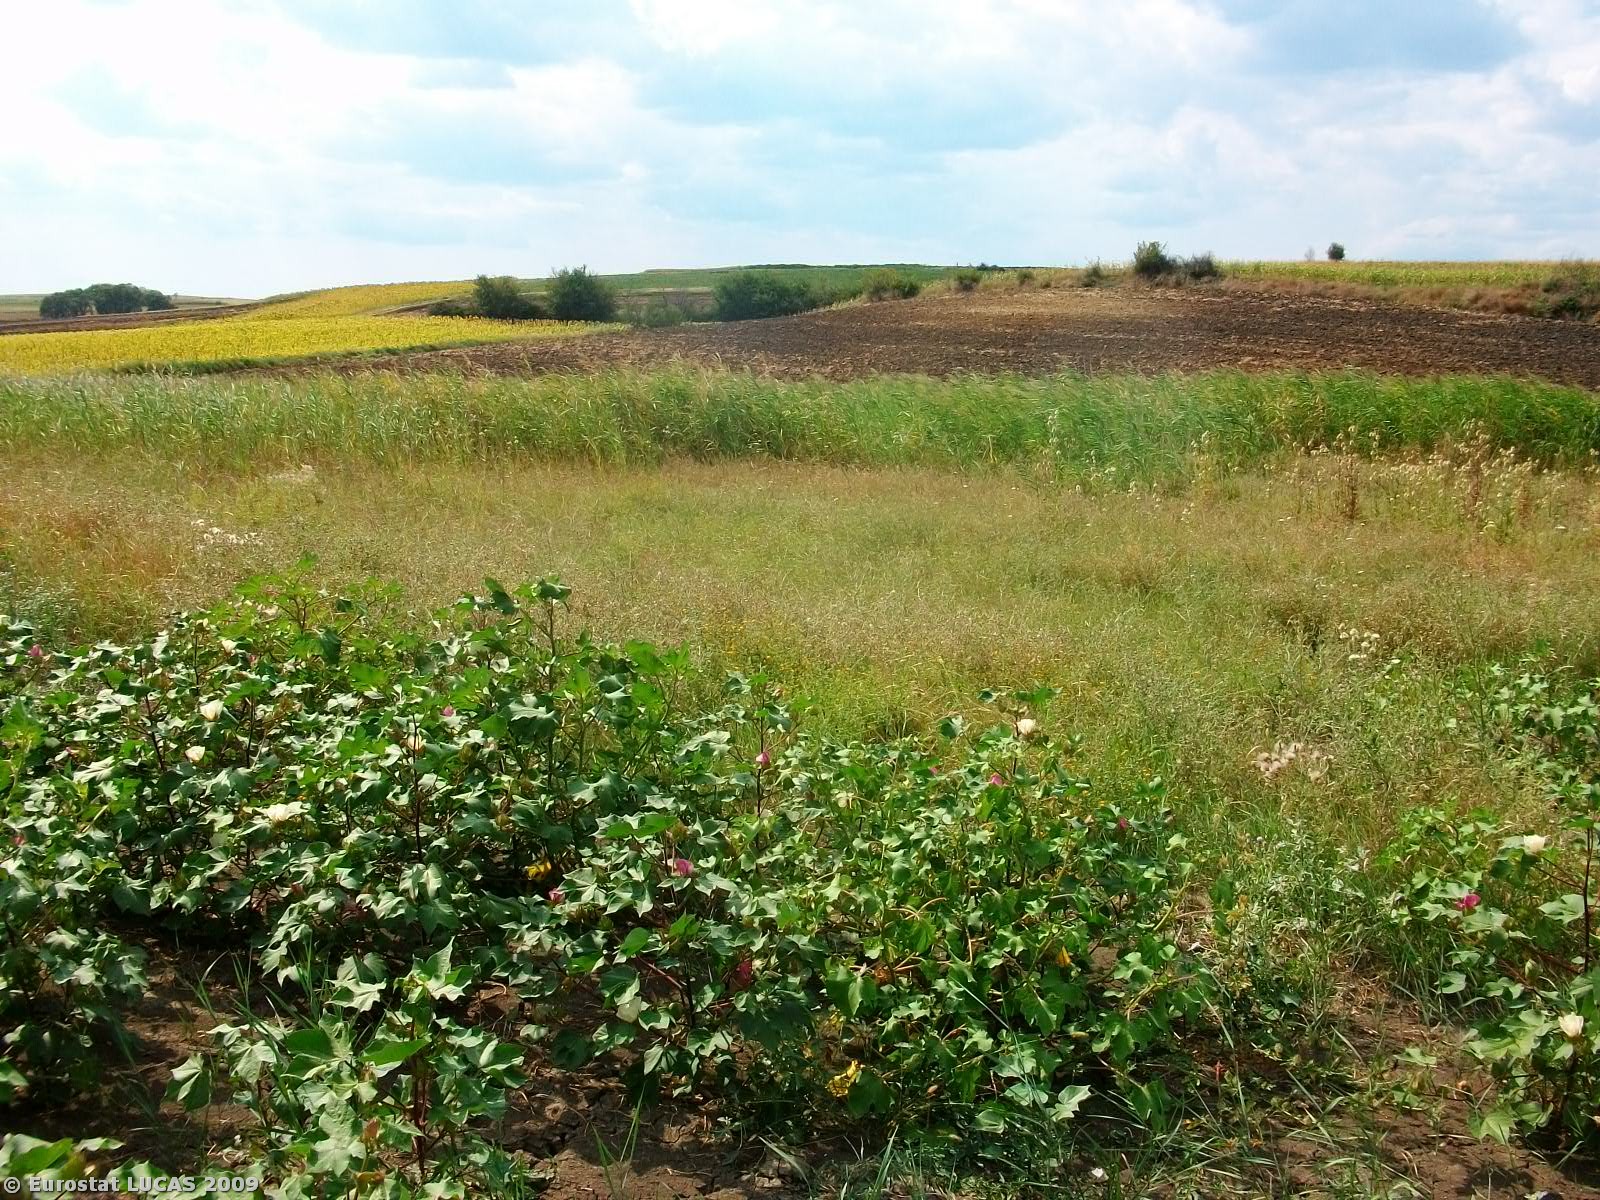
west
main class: Cropland
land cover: Cotton
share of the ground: 50 - 75 %
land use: Agriculture (excluding fallow land and kitchen gardens)
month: August
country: GR
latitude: 41.4980
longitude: 26.3550
